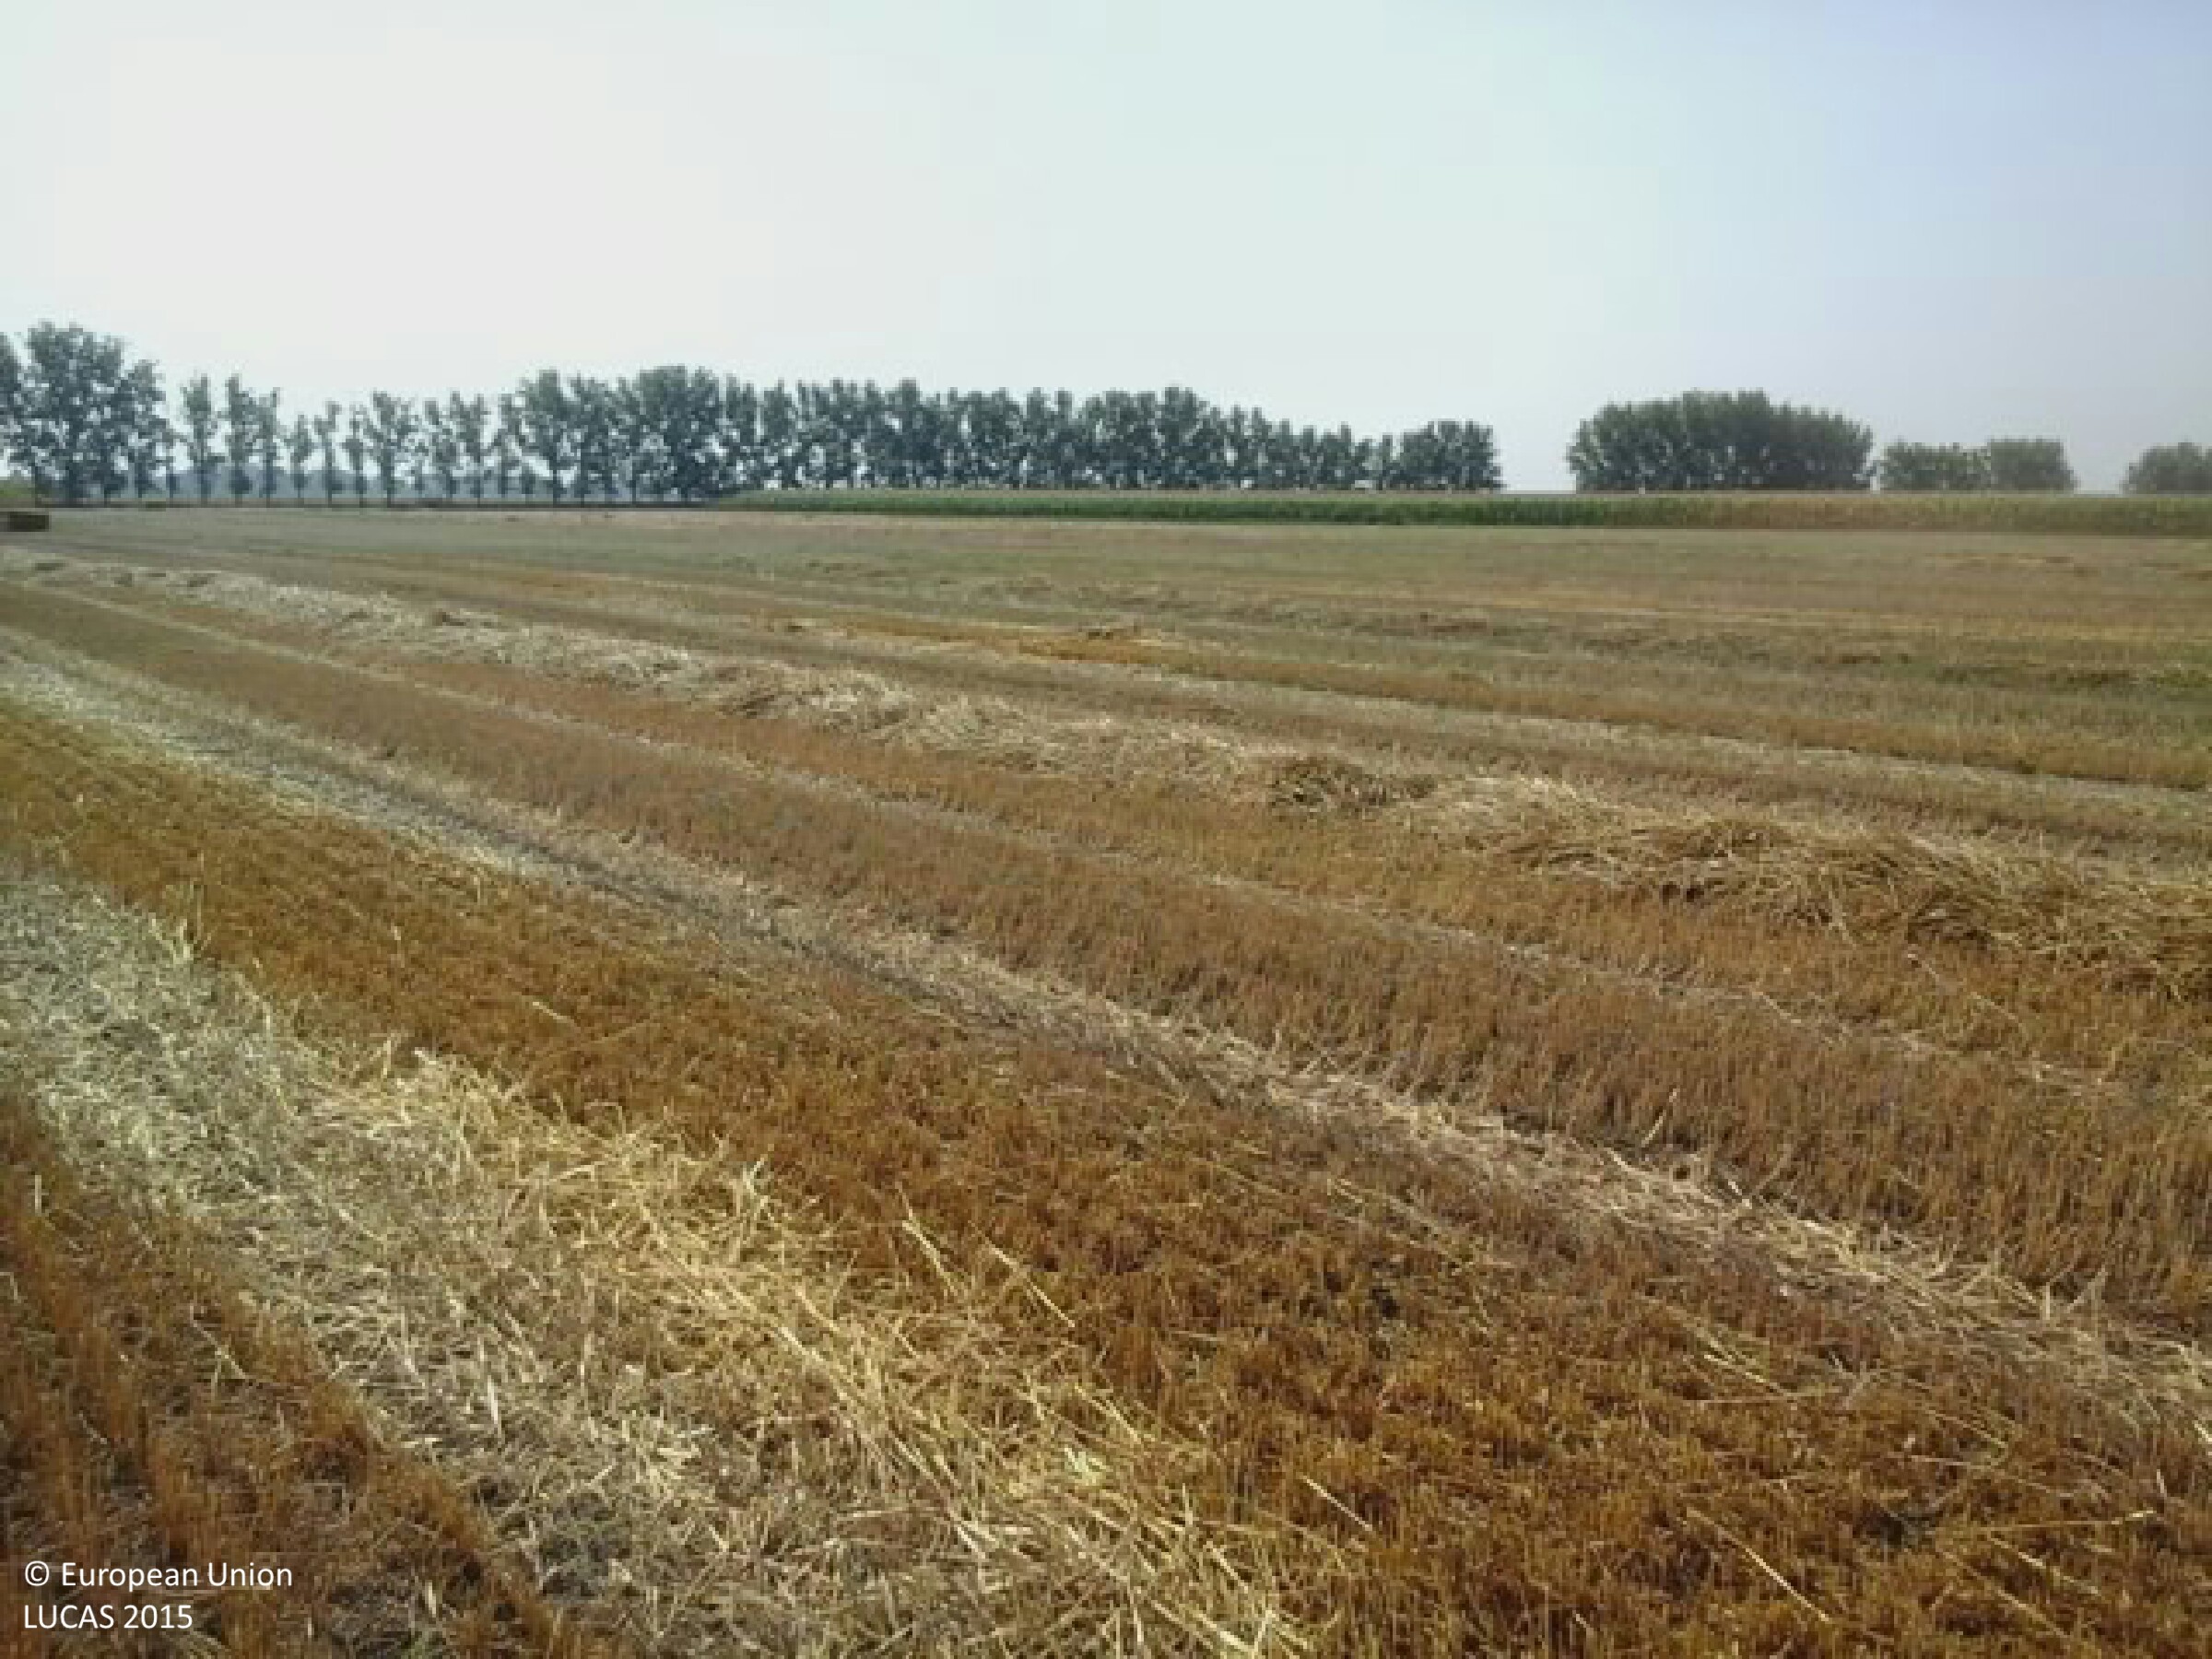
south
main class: Cropland
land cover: Common wheat
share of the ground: 25 - 50 %
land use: Agriculture (excluding fallow land and kitchen gardens)
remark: Harvested field
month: August
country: HU
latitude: 47.2359
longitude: 19.0387
